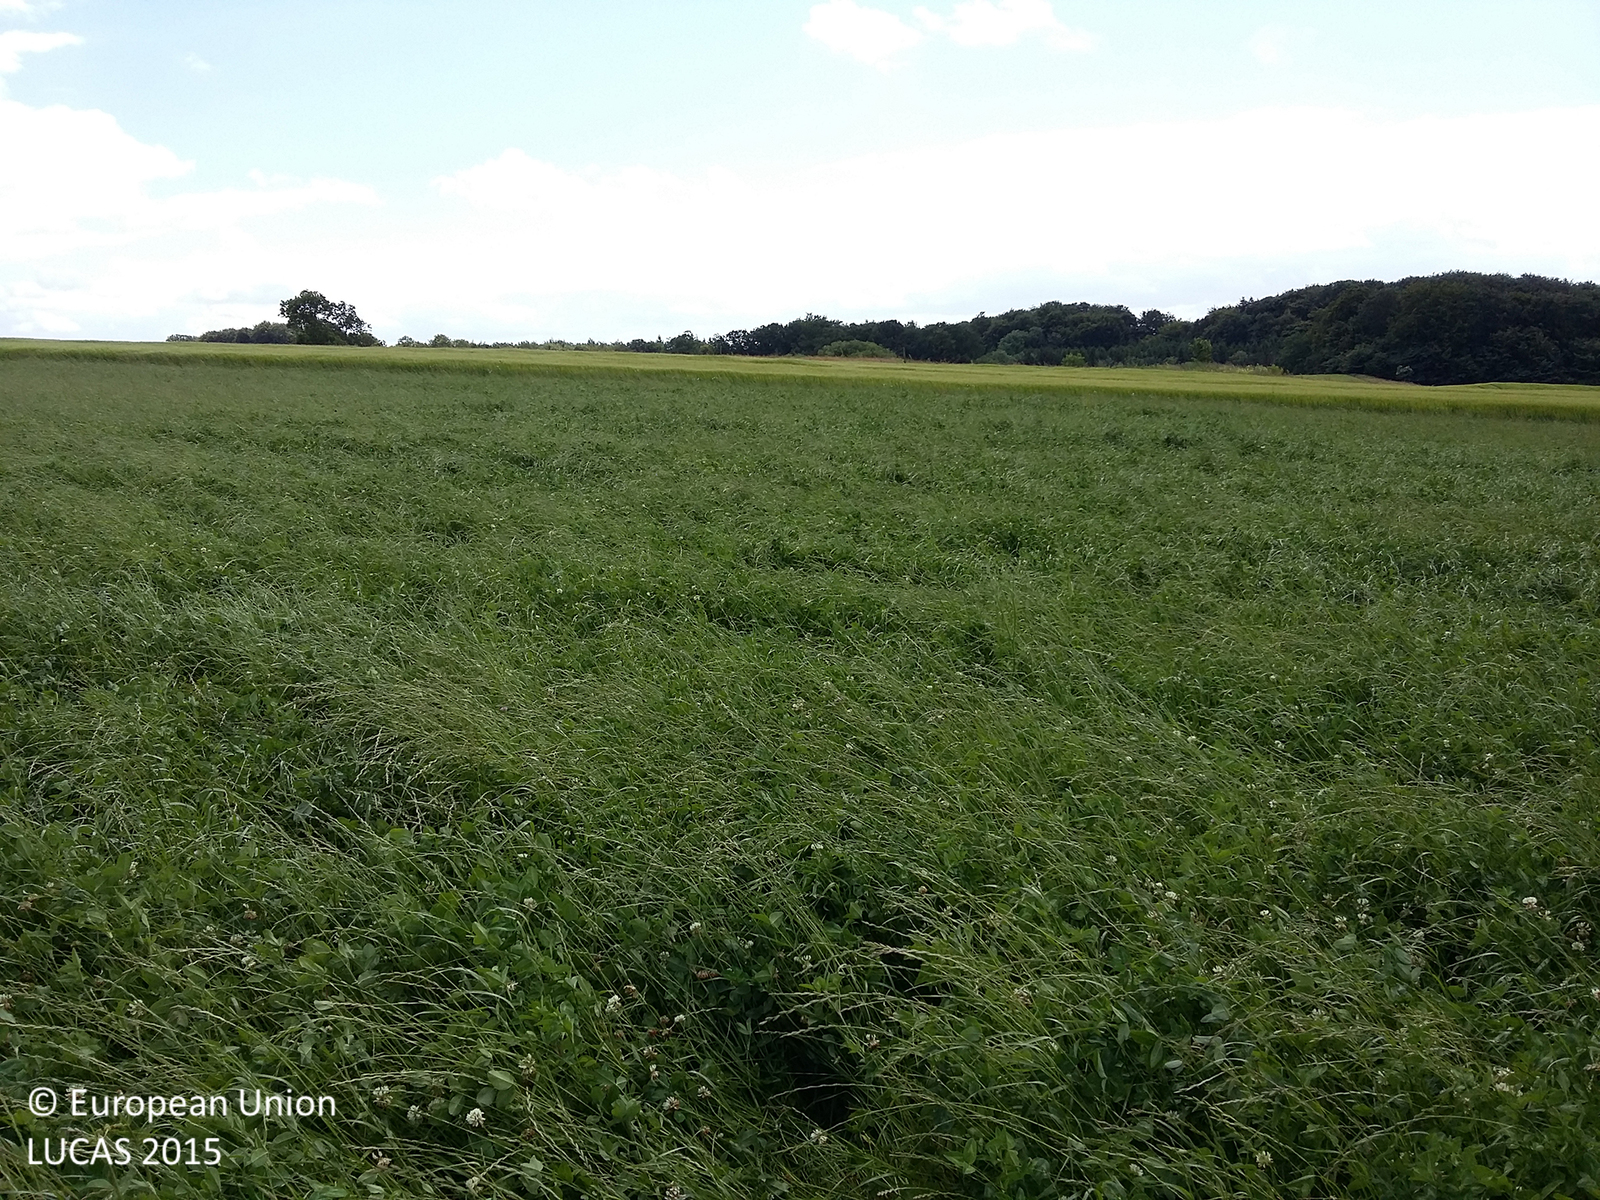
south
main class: Cropland
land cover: Clovers
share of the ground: > 75 %
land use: Agriculture (excluding fallow land and kitchen gardens)
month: July
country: DK
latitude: 55.2208
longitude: 11.9006
